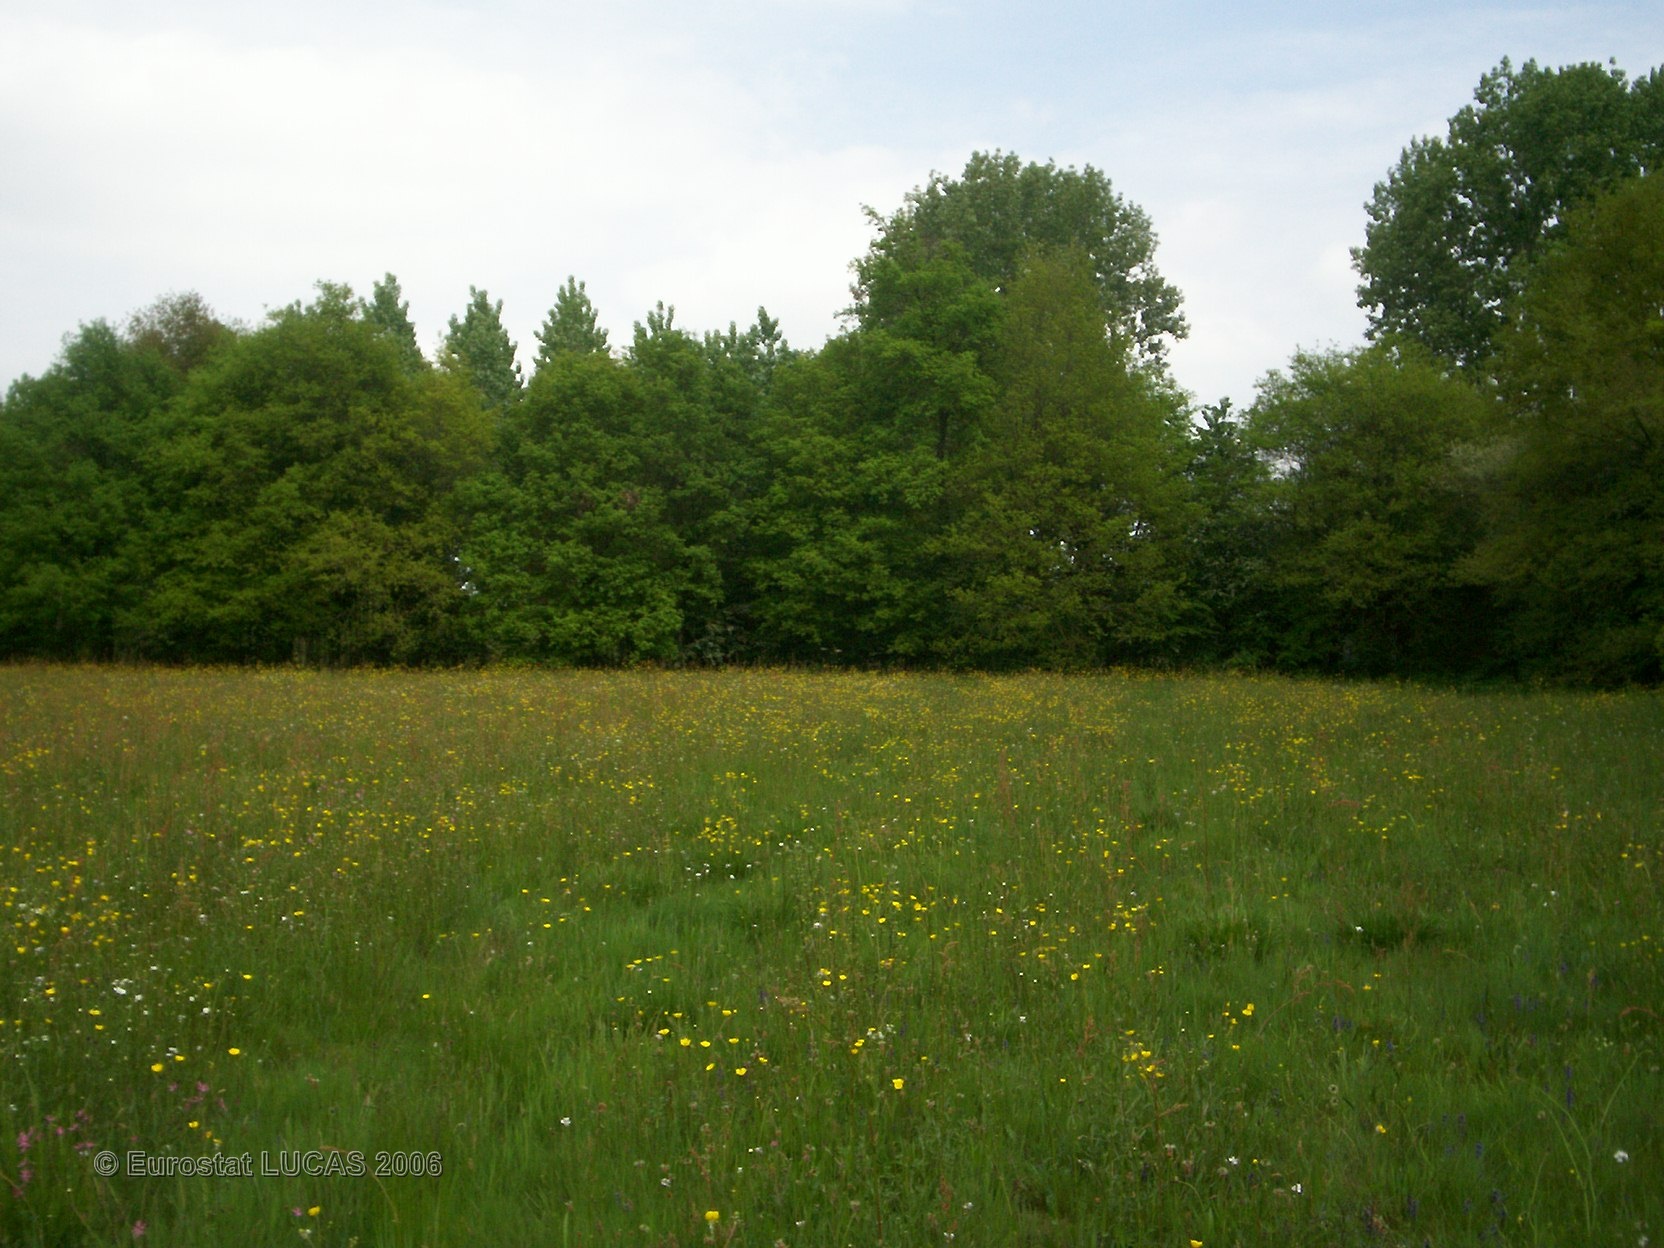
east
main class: Grassland
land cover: Grassland without tree/shrub cover
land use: Agriculture (excluding fallow land and kitchen gardens)
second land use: Amenities, museums, leisure
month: May
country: FR
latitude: 46.8555
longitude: -0.9852
